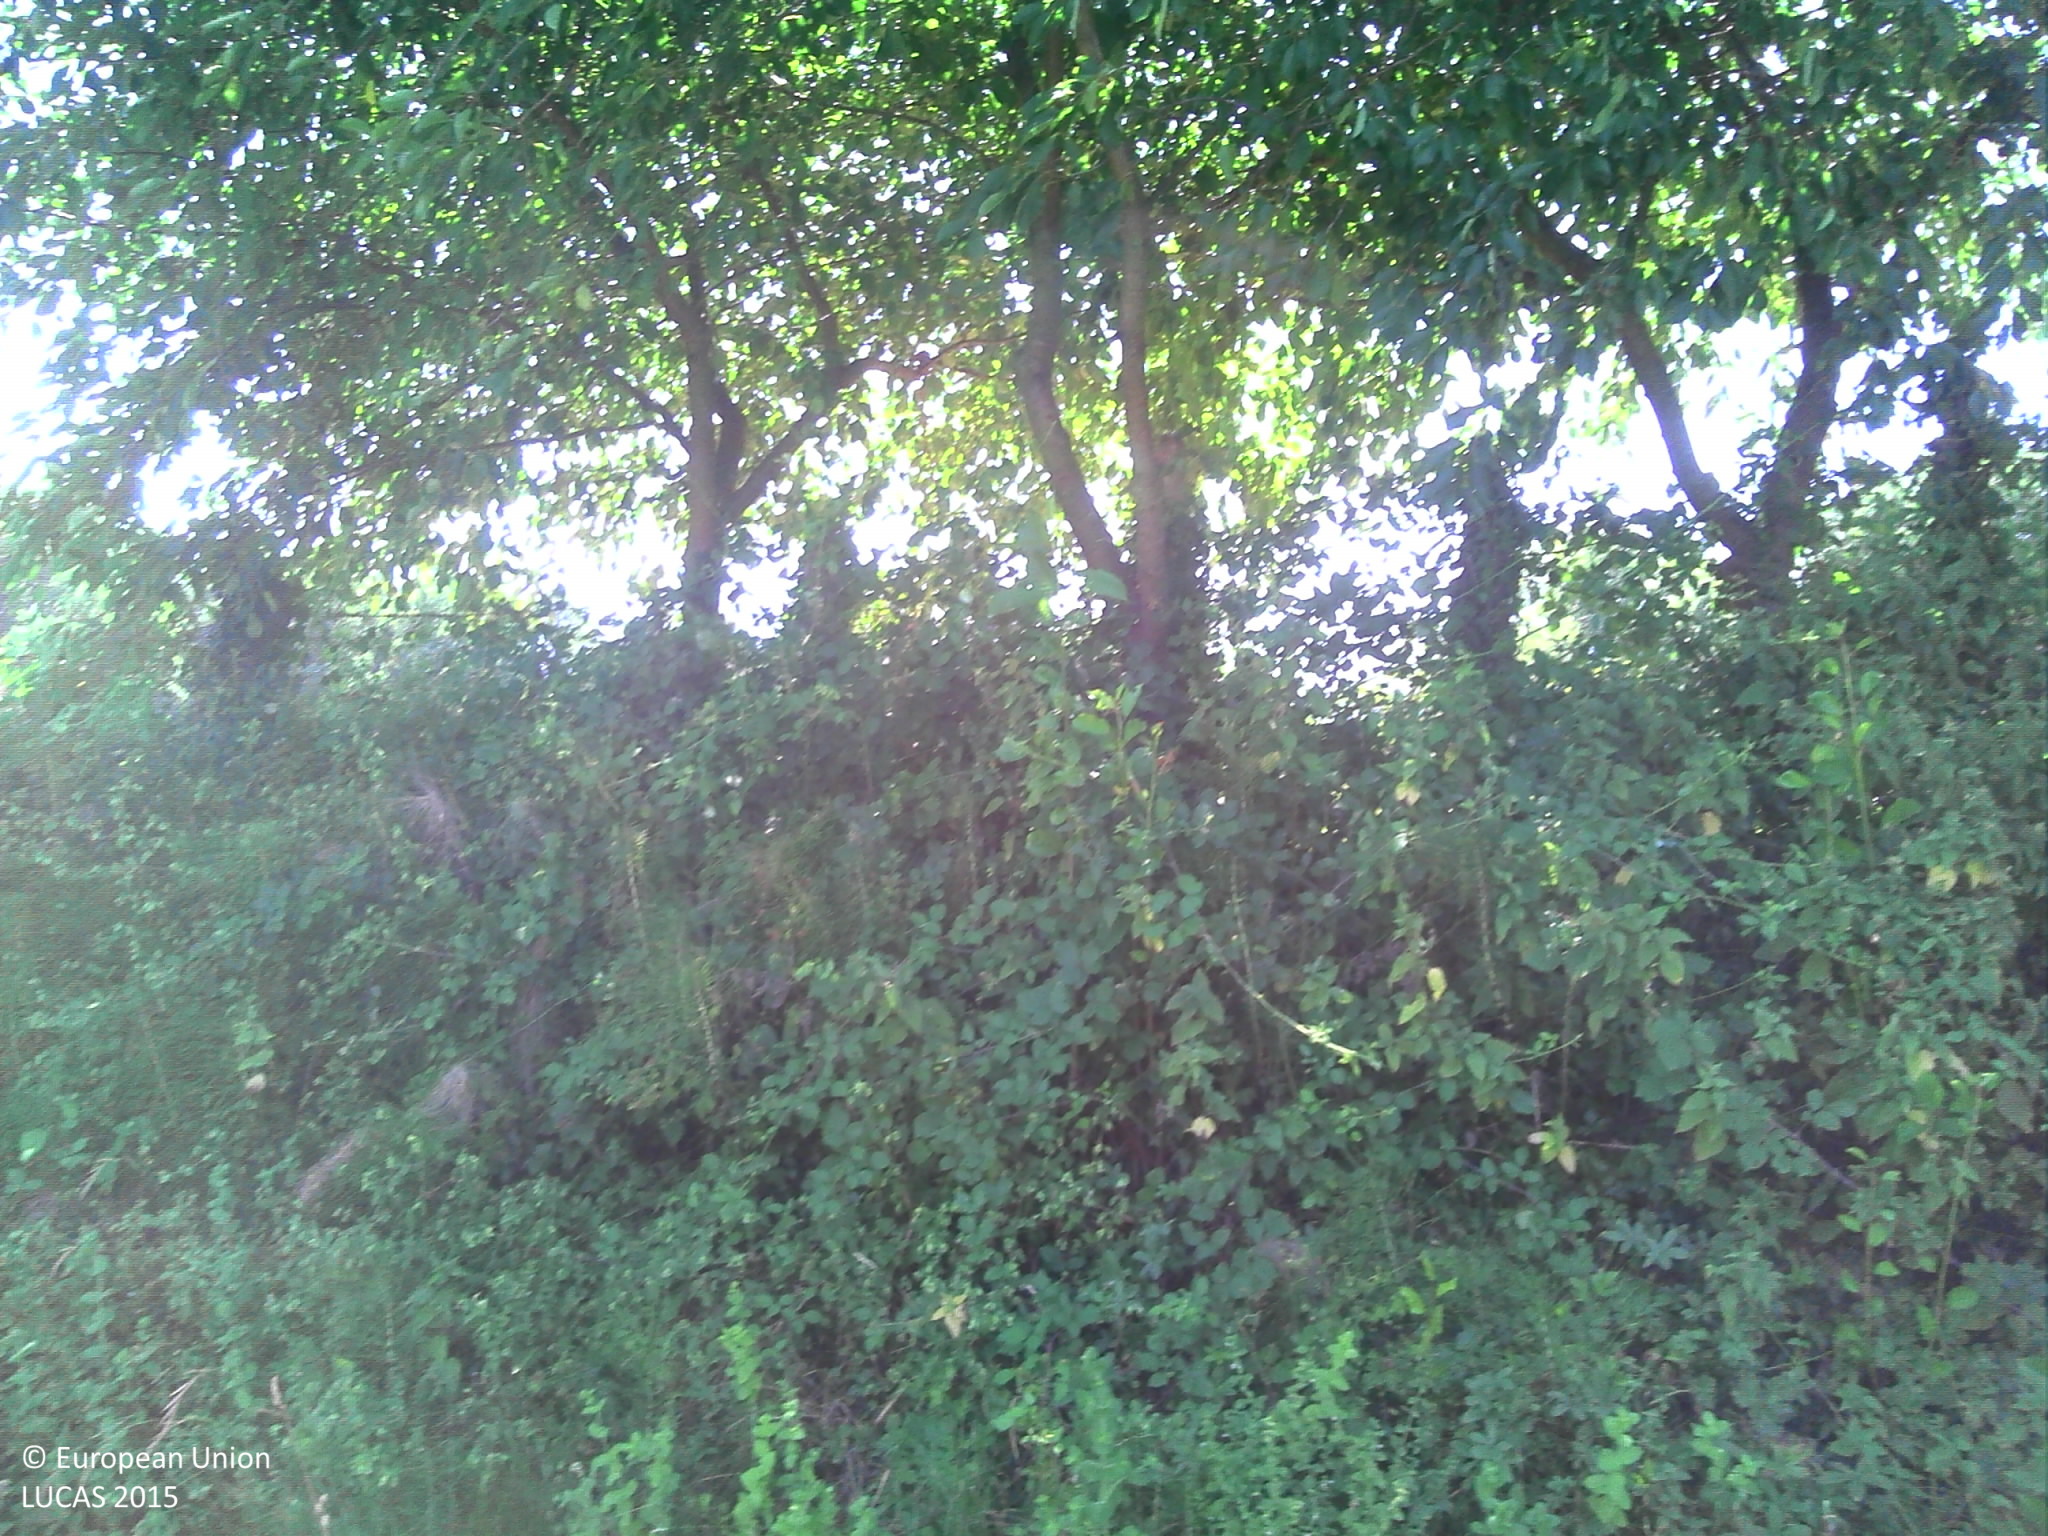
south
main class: Cropland
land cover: Maize
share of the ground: > 75 %
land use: Agriculture (excluding fallow land and kitchen gardens)
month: July
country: FR
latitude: 45.2366
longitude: 4.8968
